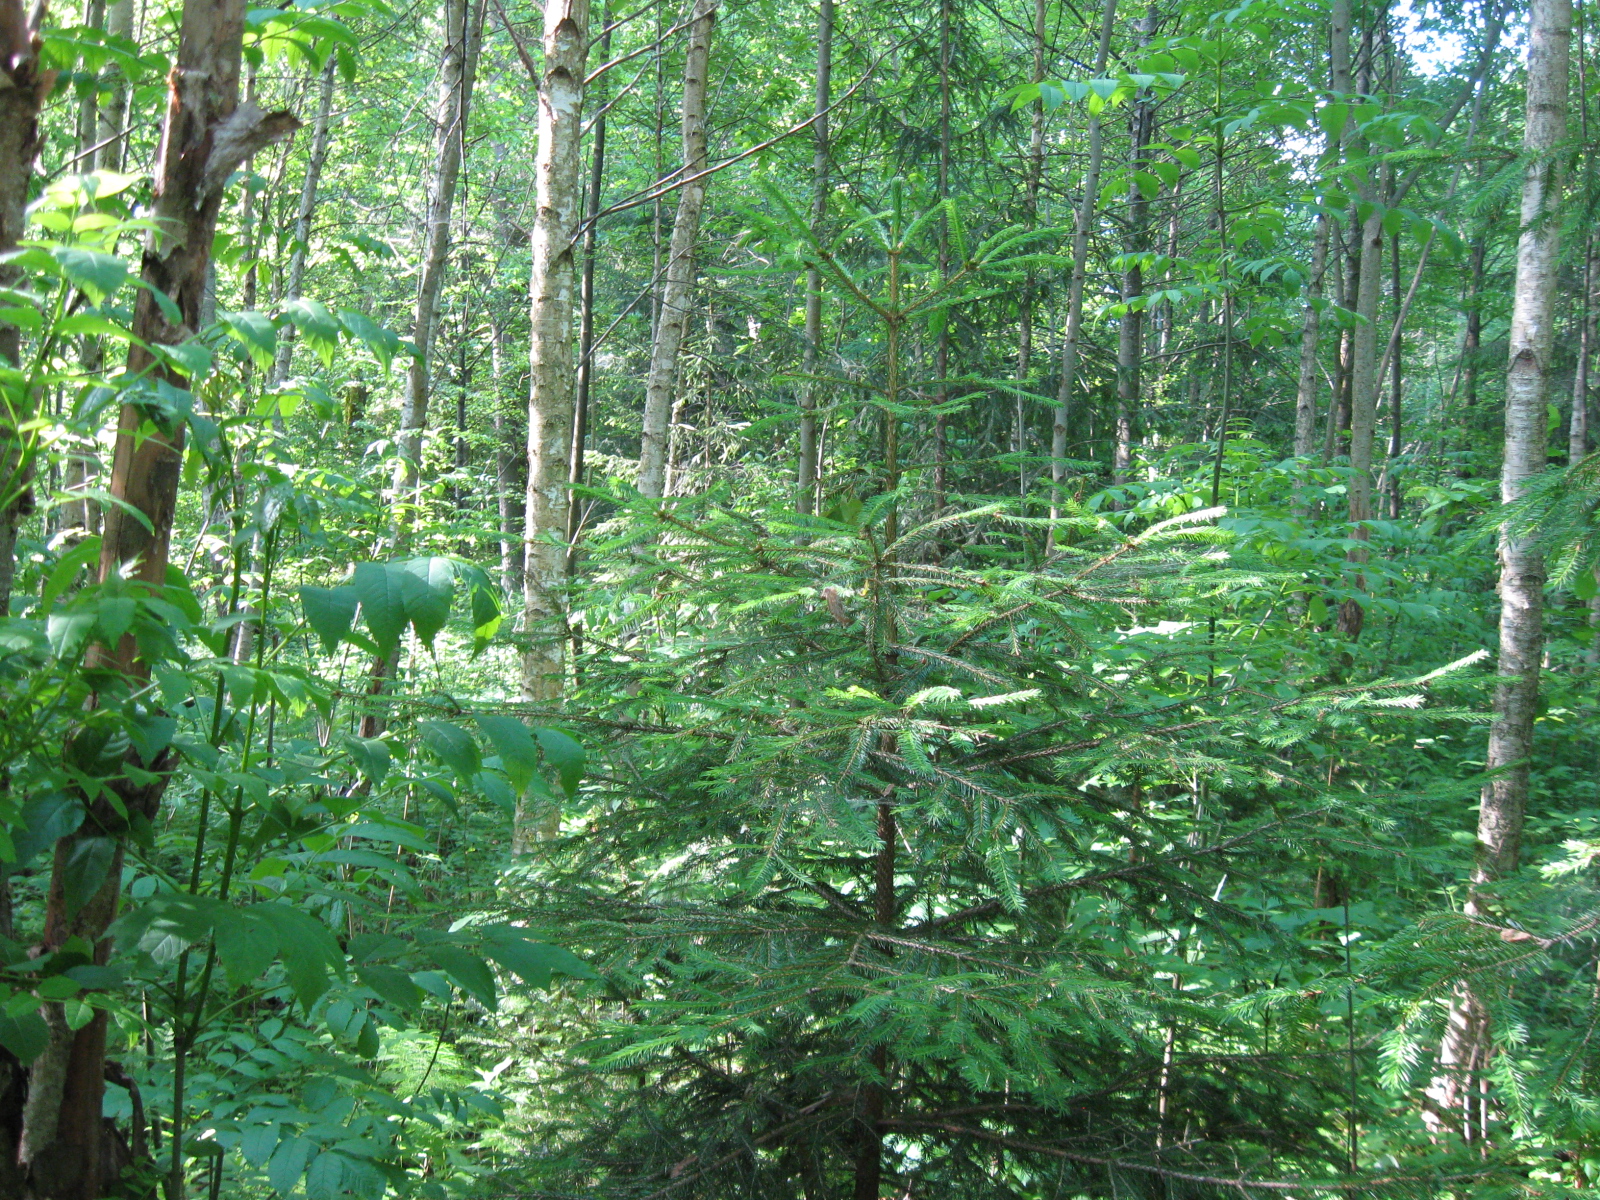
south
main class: Woodland
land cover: Spruce dominated mixed woodland
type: hemiboreal forest and nemoral coniferous forest and mixed broadleaved-coniferous forest
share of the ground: > 75 %
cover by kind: broadleaved forest trees 70 %, coniferous forest trees 30 %
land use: Forestry
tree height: > 5 m
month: June
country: LT
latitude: 54.5281
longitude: 23.7621
